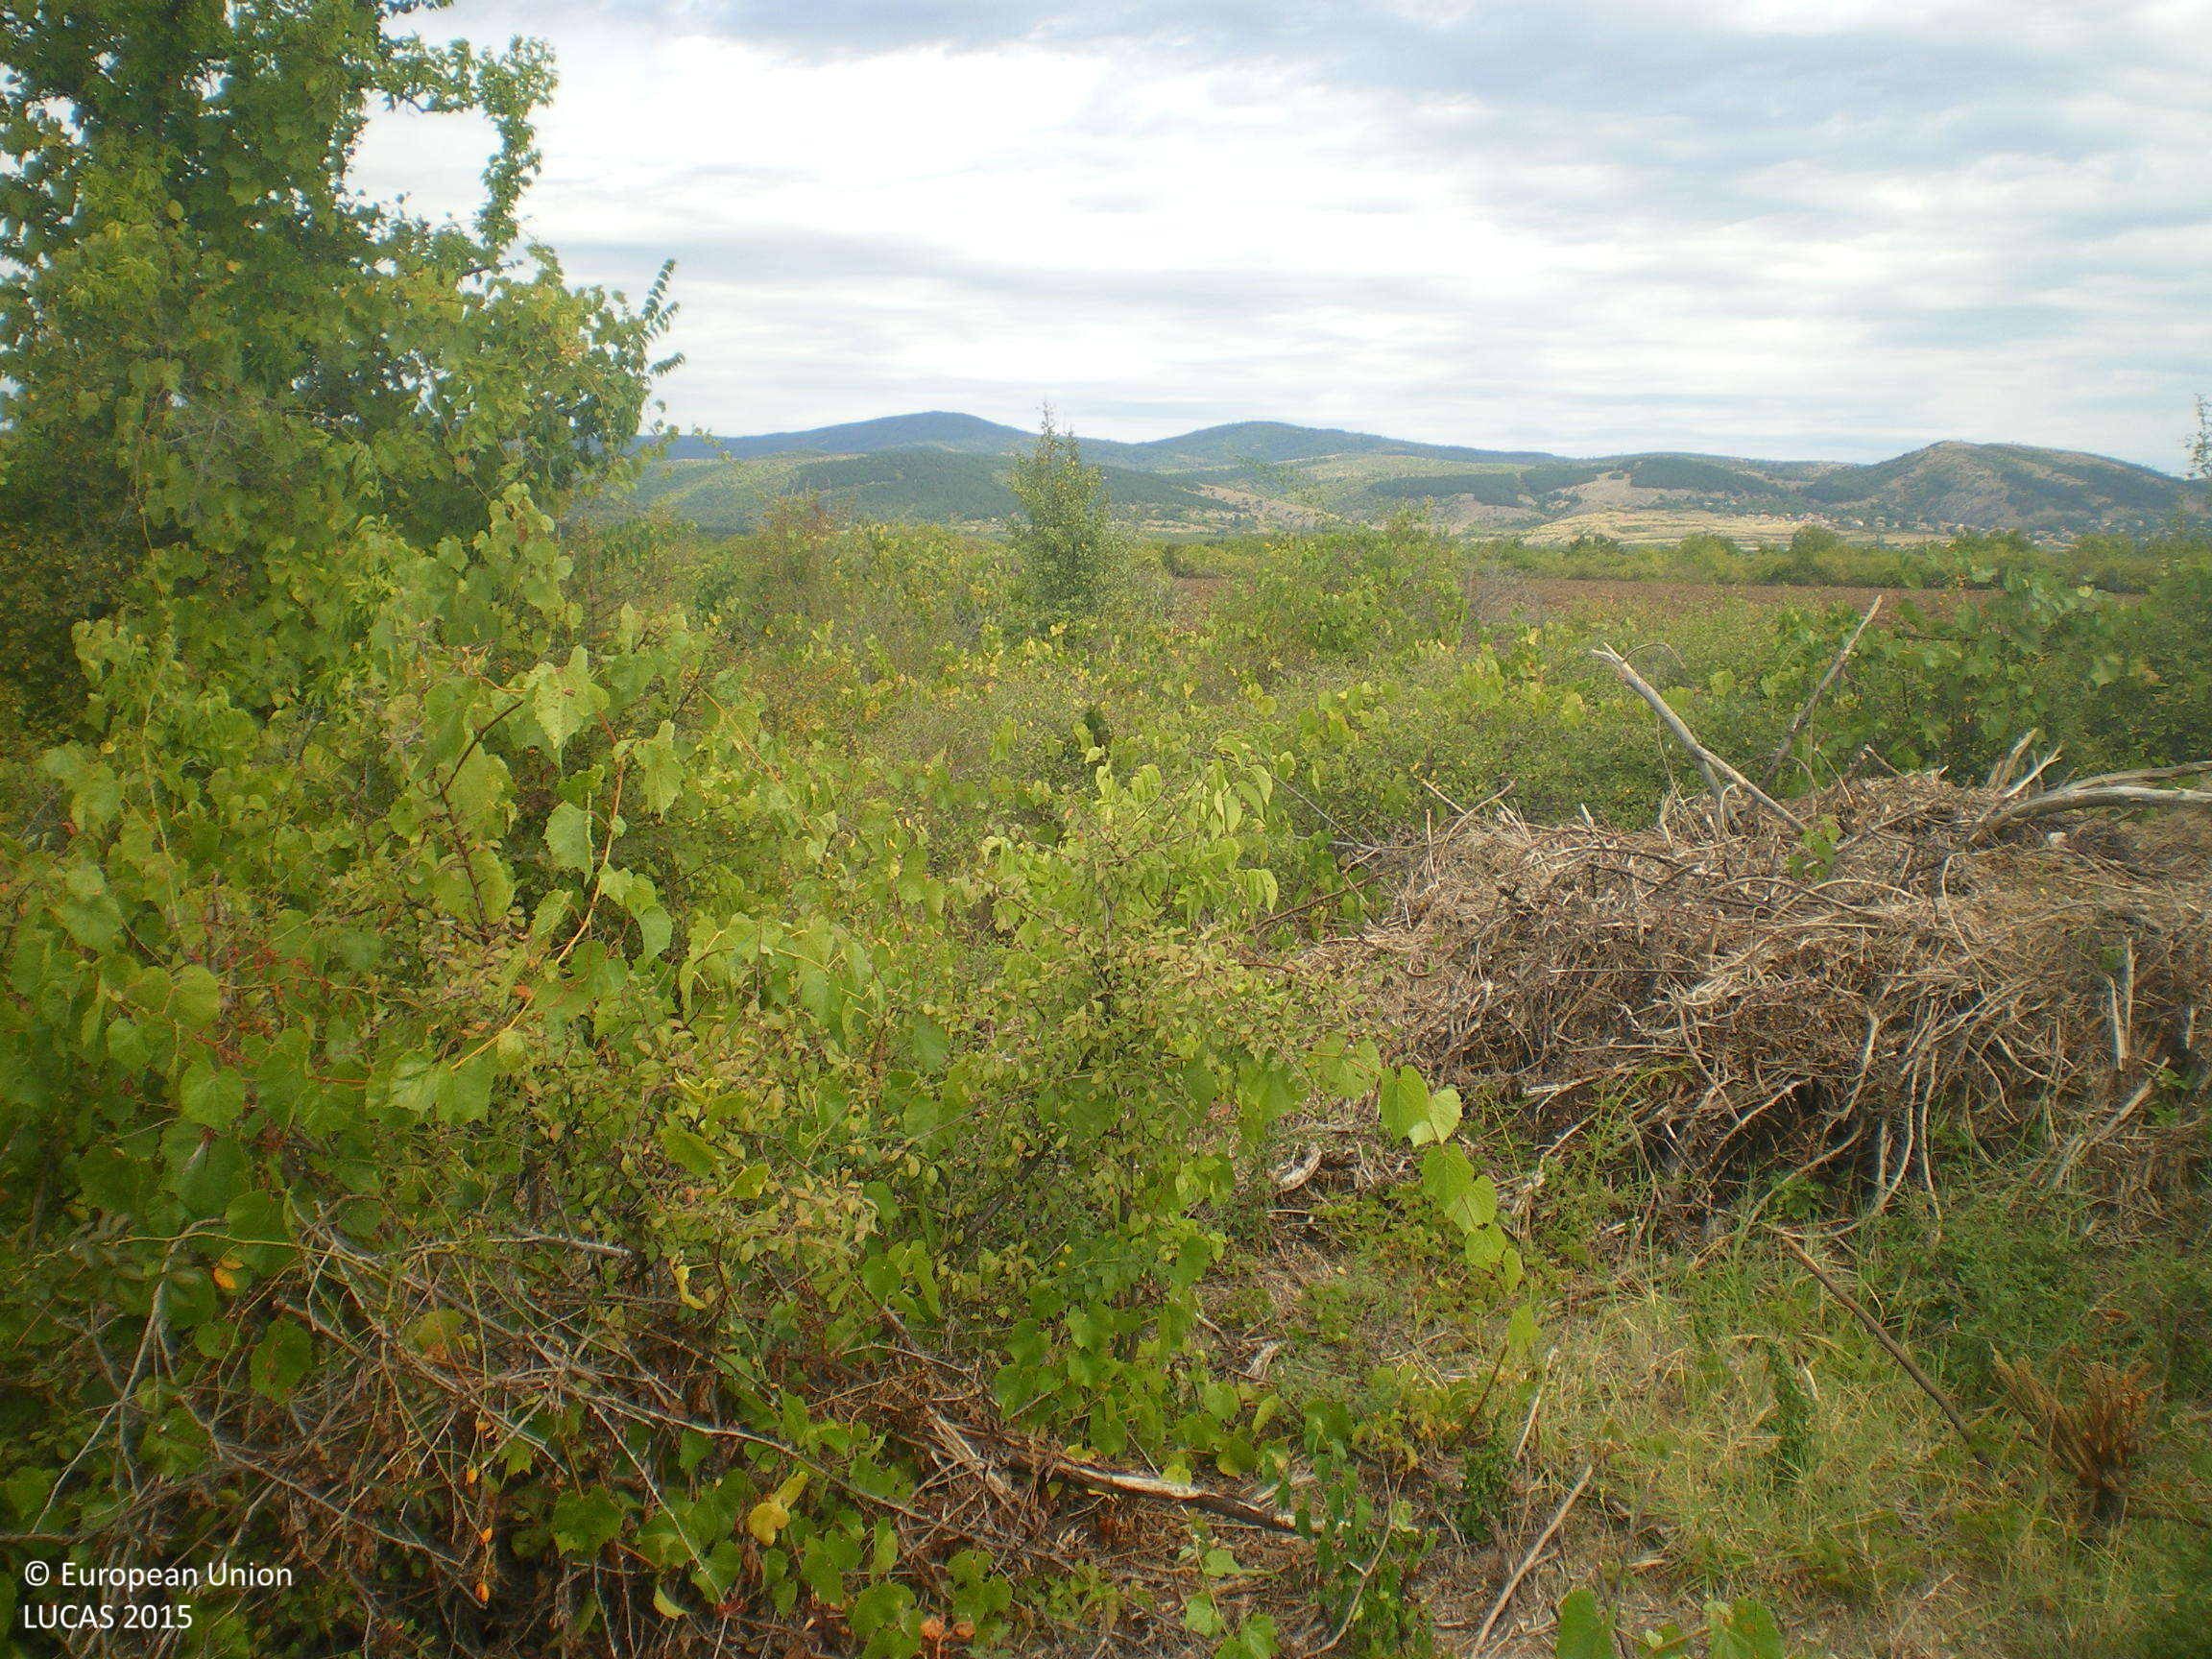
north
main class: Cropland
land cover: Vineyards
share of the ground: > 75 %
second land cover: Shrubland without tree cover
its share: > 75 %
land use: Abandoned areas
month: September
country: BG
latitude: 42.4595
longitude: 25.7500
